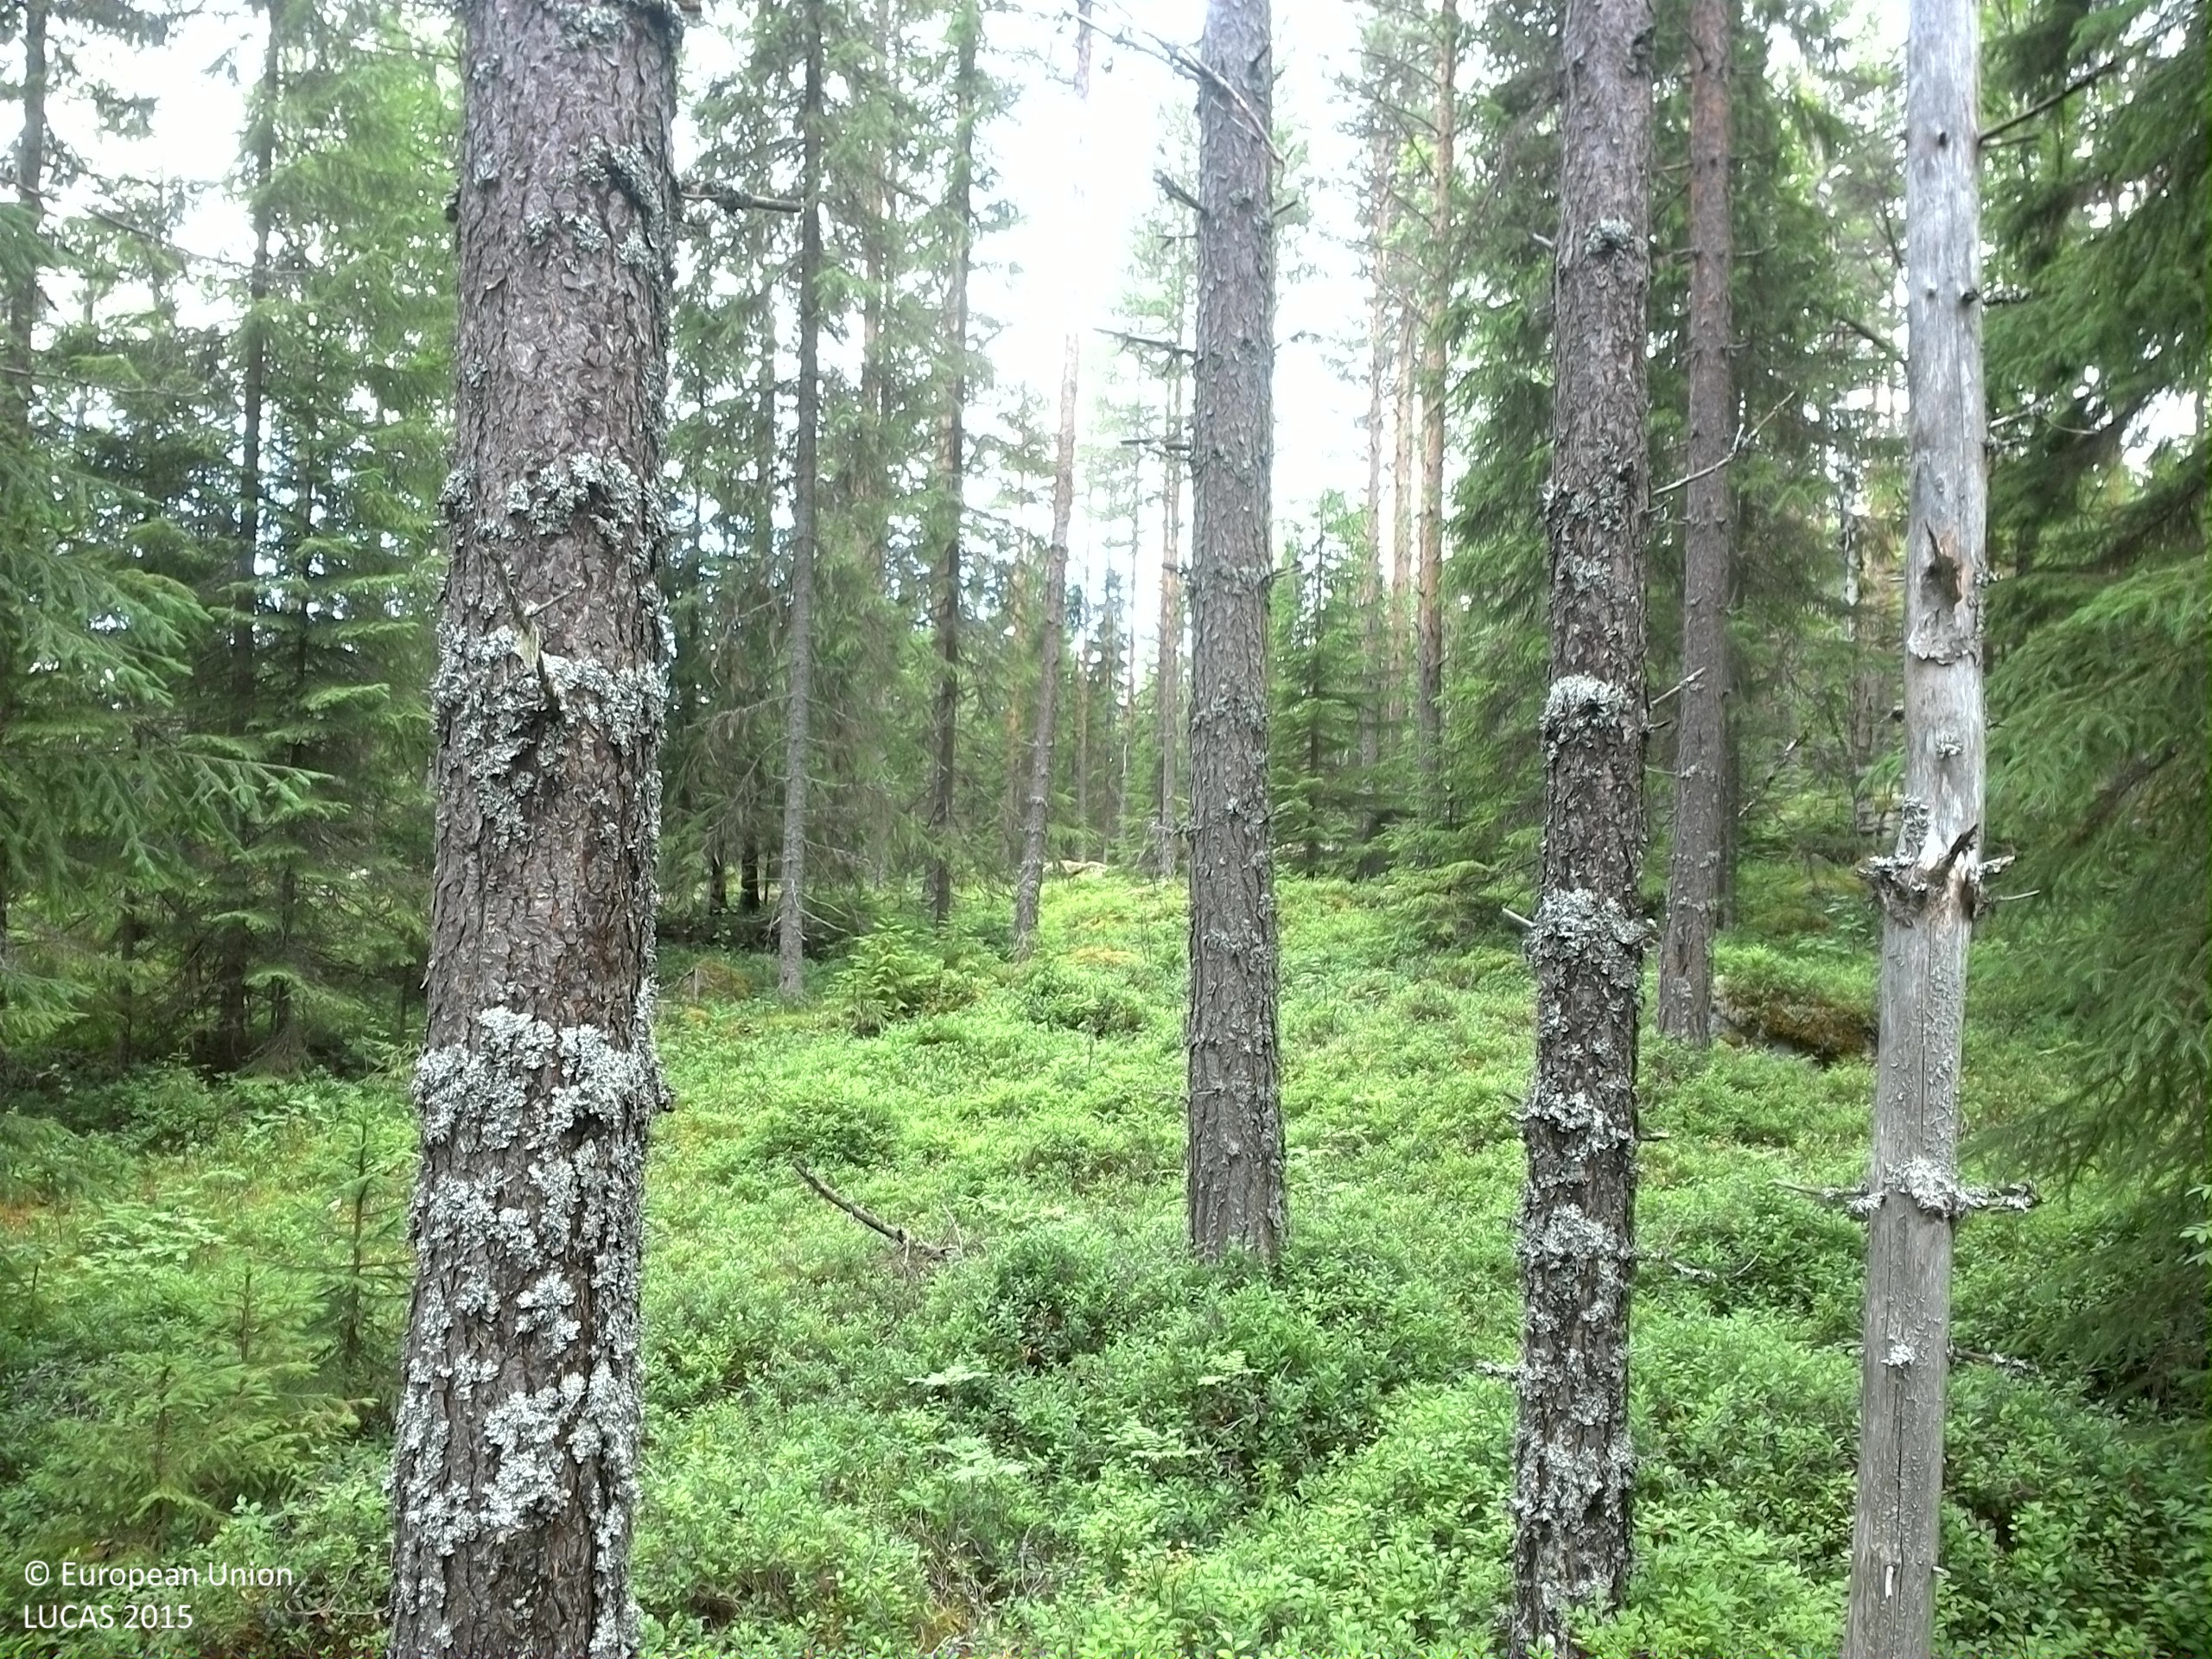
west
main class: Woodland
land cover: Pine dominated coniferous woodland
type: boreal forest
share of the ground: 50 - 75 %
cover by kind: coniferous forest trees 50 %, shrubs 30 %, lichens and mosses 10 %, broadleaved forest trees 5 %, herbaceous plants 5 %
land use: Forestry
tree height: > 5 m
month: July
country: SE
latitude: 62.7176
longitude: 17.0768
